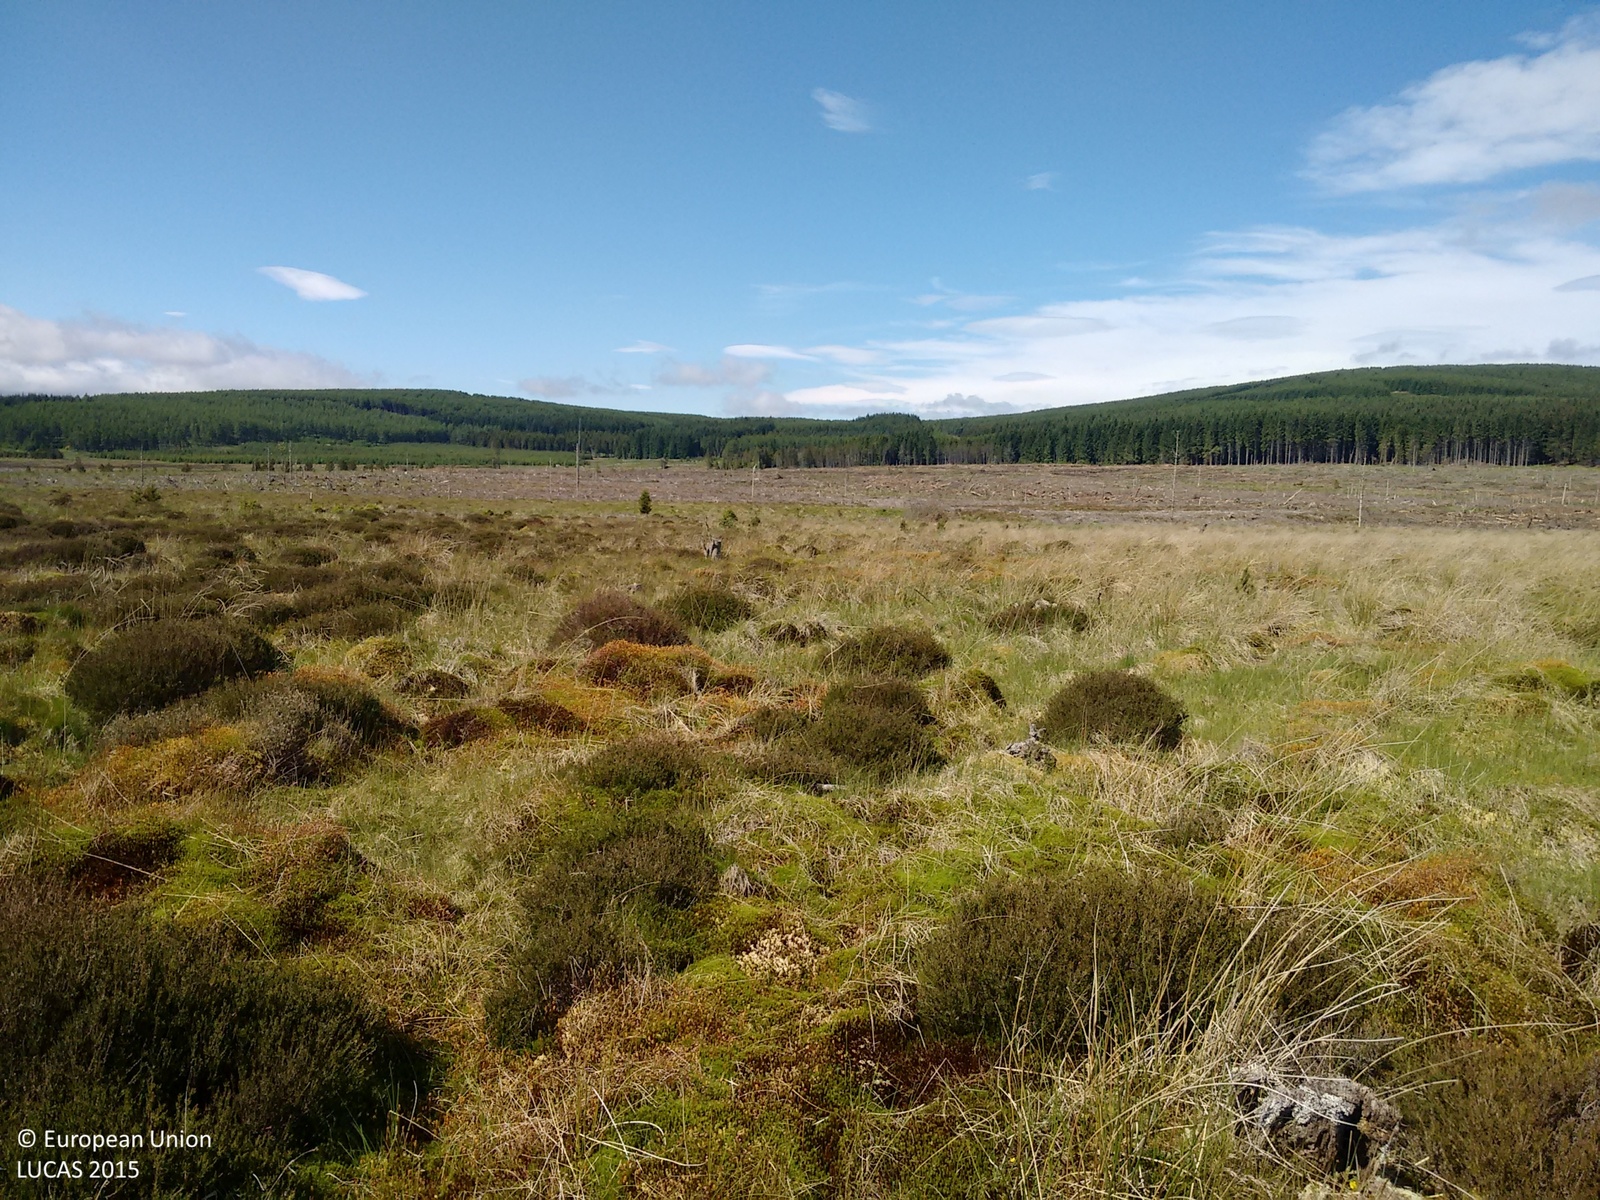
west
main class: Shrubland
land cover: Shrubland without tree cover
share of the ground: > 75 %
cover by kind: herbaceous plants 60 %, shrubs 30 %, lichens and mosses 10 %
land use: Semi-natural and natural areas not in use
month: June
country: GB
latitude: 57.3354
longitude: -2.9355
